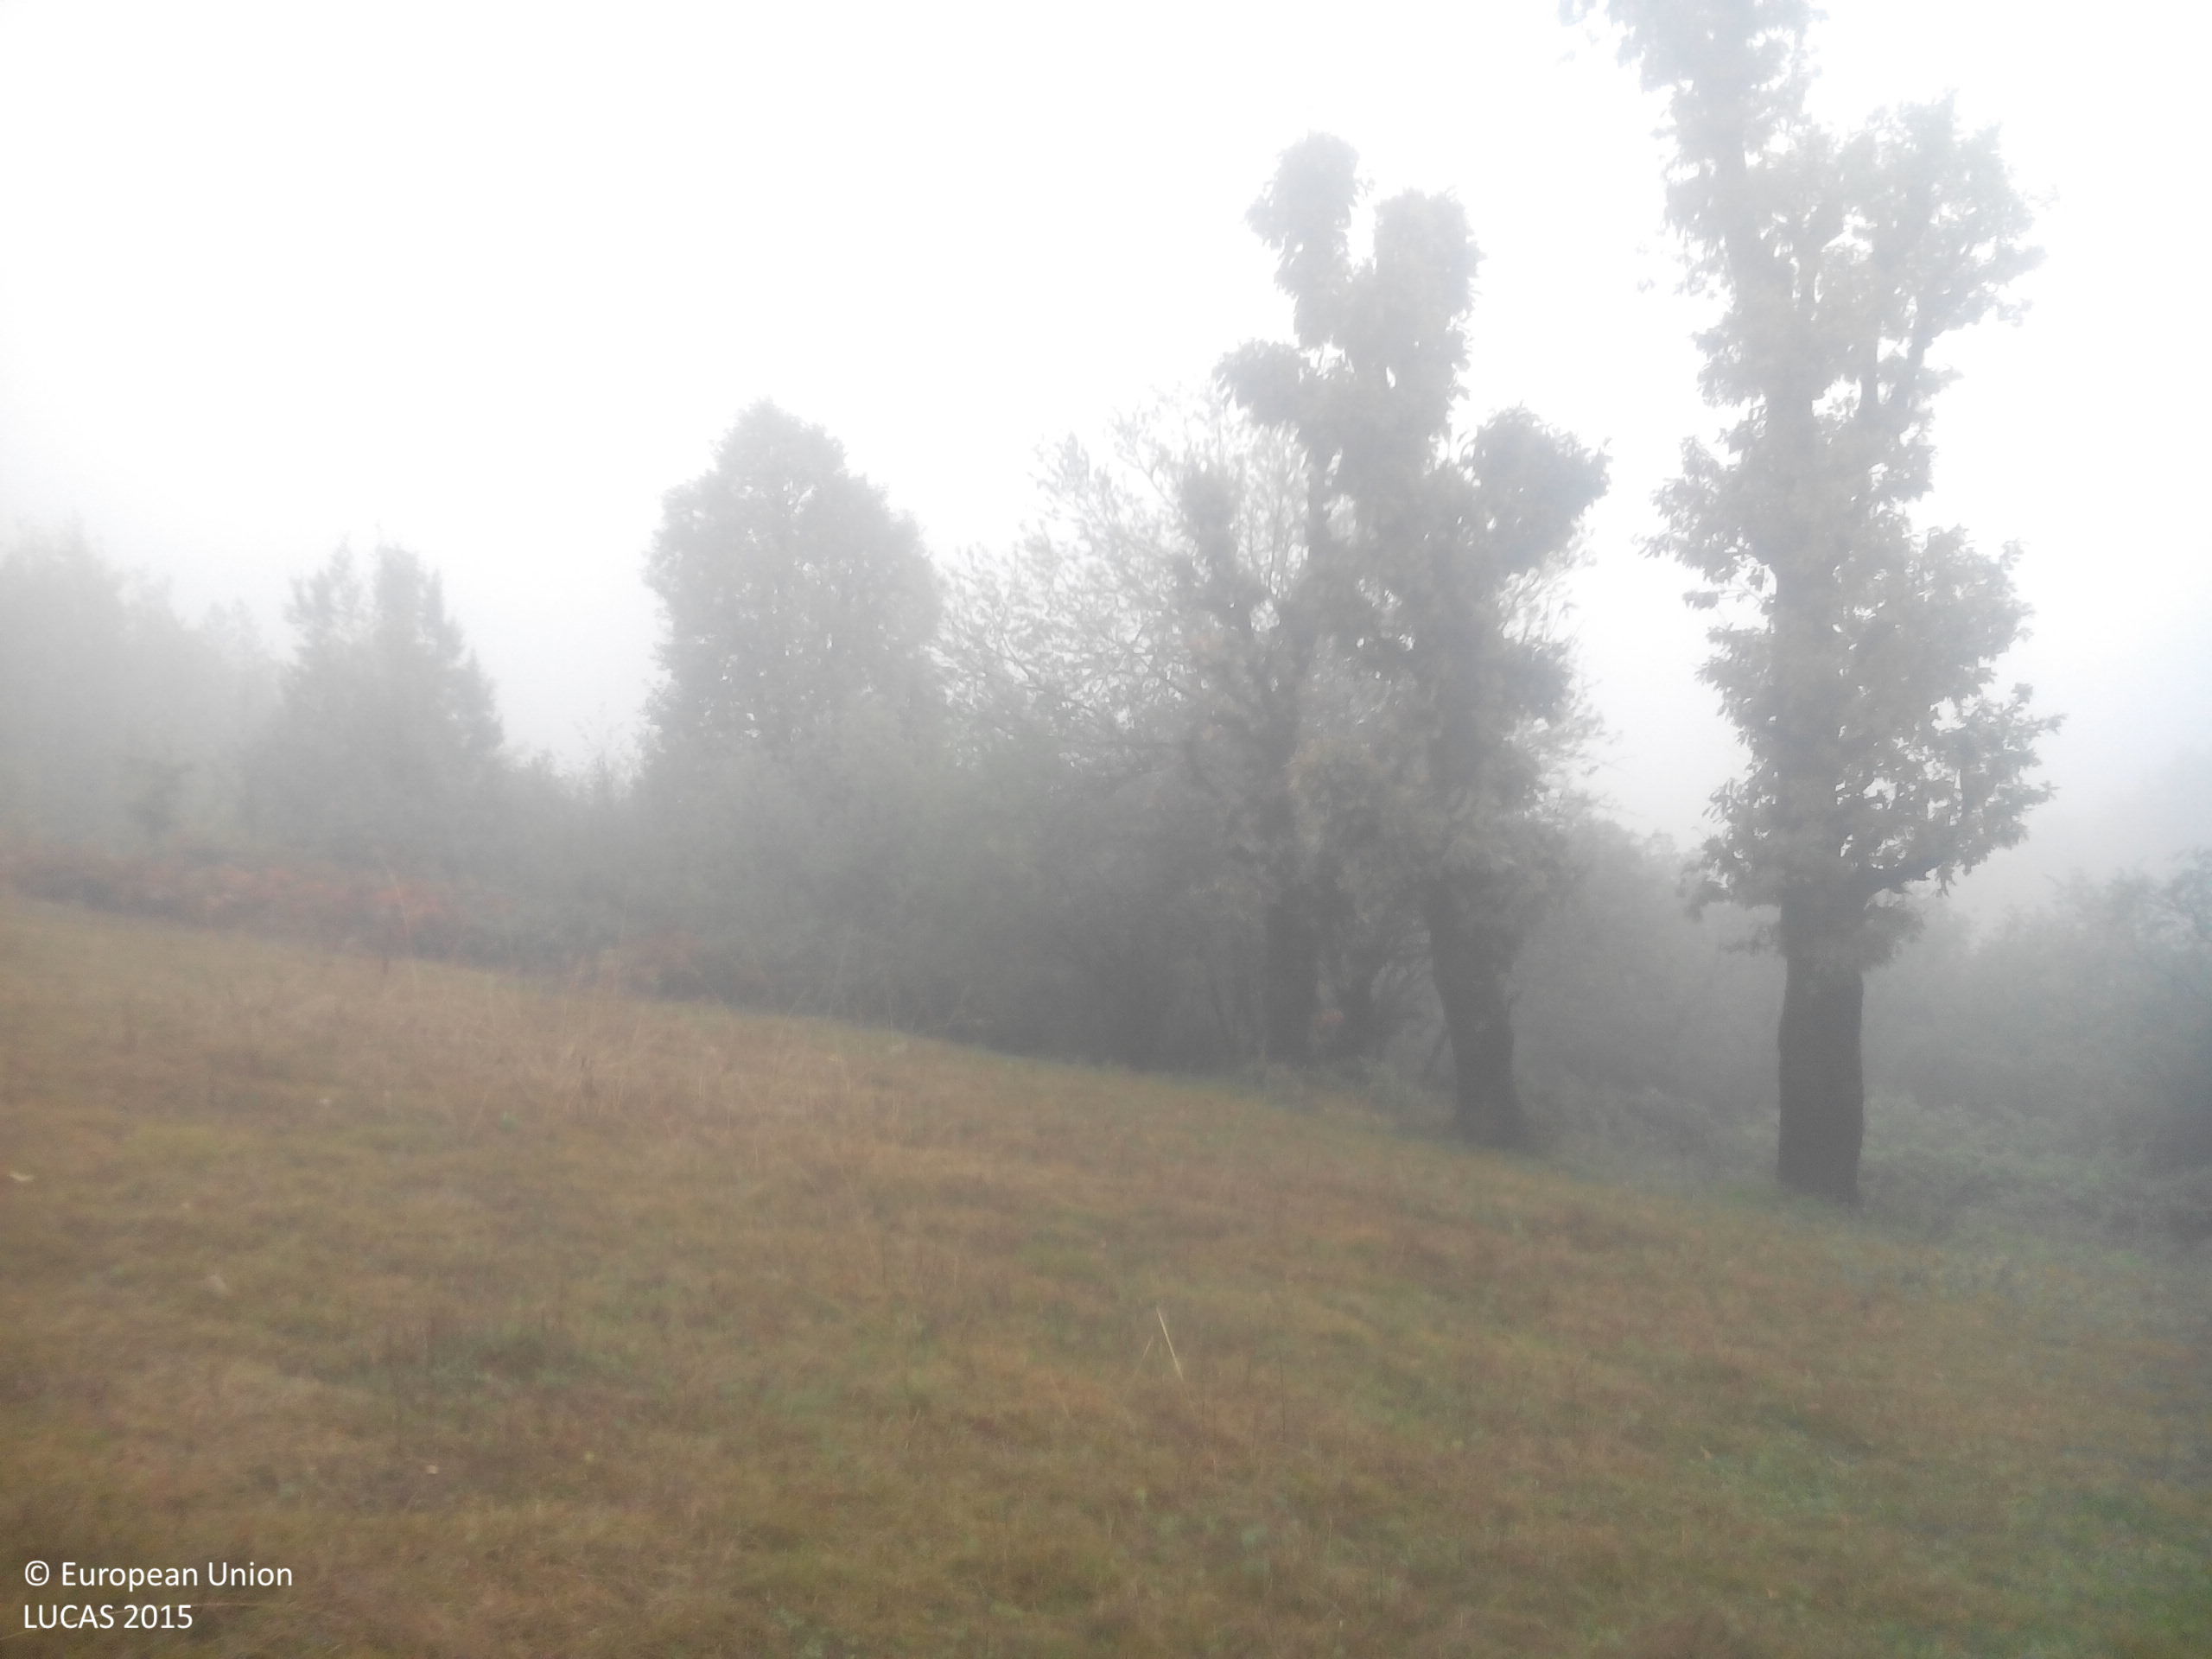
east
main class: Grassland
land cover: Grassland with sparse tree/shrub cover
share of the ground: > 75 %
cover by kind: herbaceous plants 90 %, broadleaved forest trees 5 %, shrubs 5 %
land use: Agriculture (excluding fallow land and kitchen gardens)
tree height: > 5 m
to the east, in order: Grassland with sparse tree/shrub cover; Broadleaved woodland
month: October
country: BG
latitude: 42.9716
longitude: 24.2875
